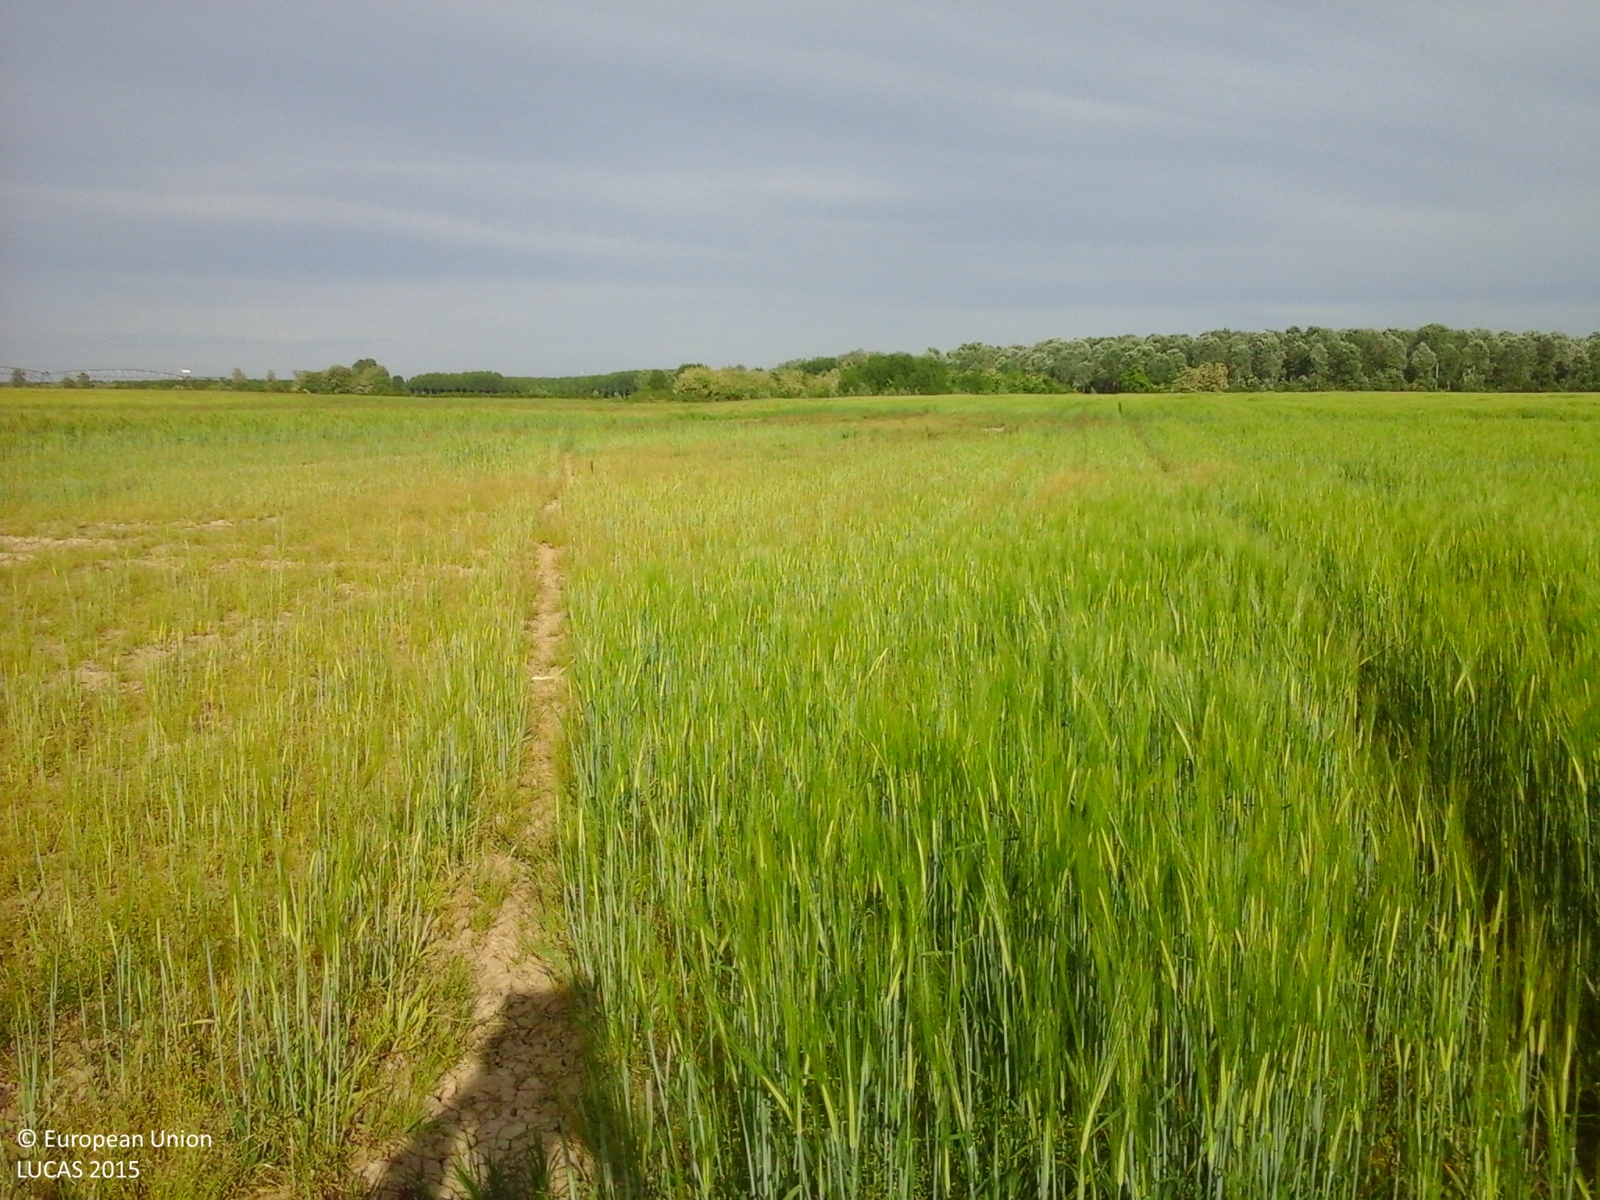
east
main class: Cropland
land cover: Barley
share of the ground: > 75 %
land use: Agriculture (excluding fallow land and kitchen gardens)
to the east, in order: Barley
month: May
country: IT
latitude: 45.1056
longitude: 9.3023
